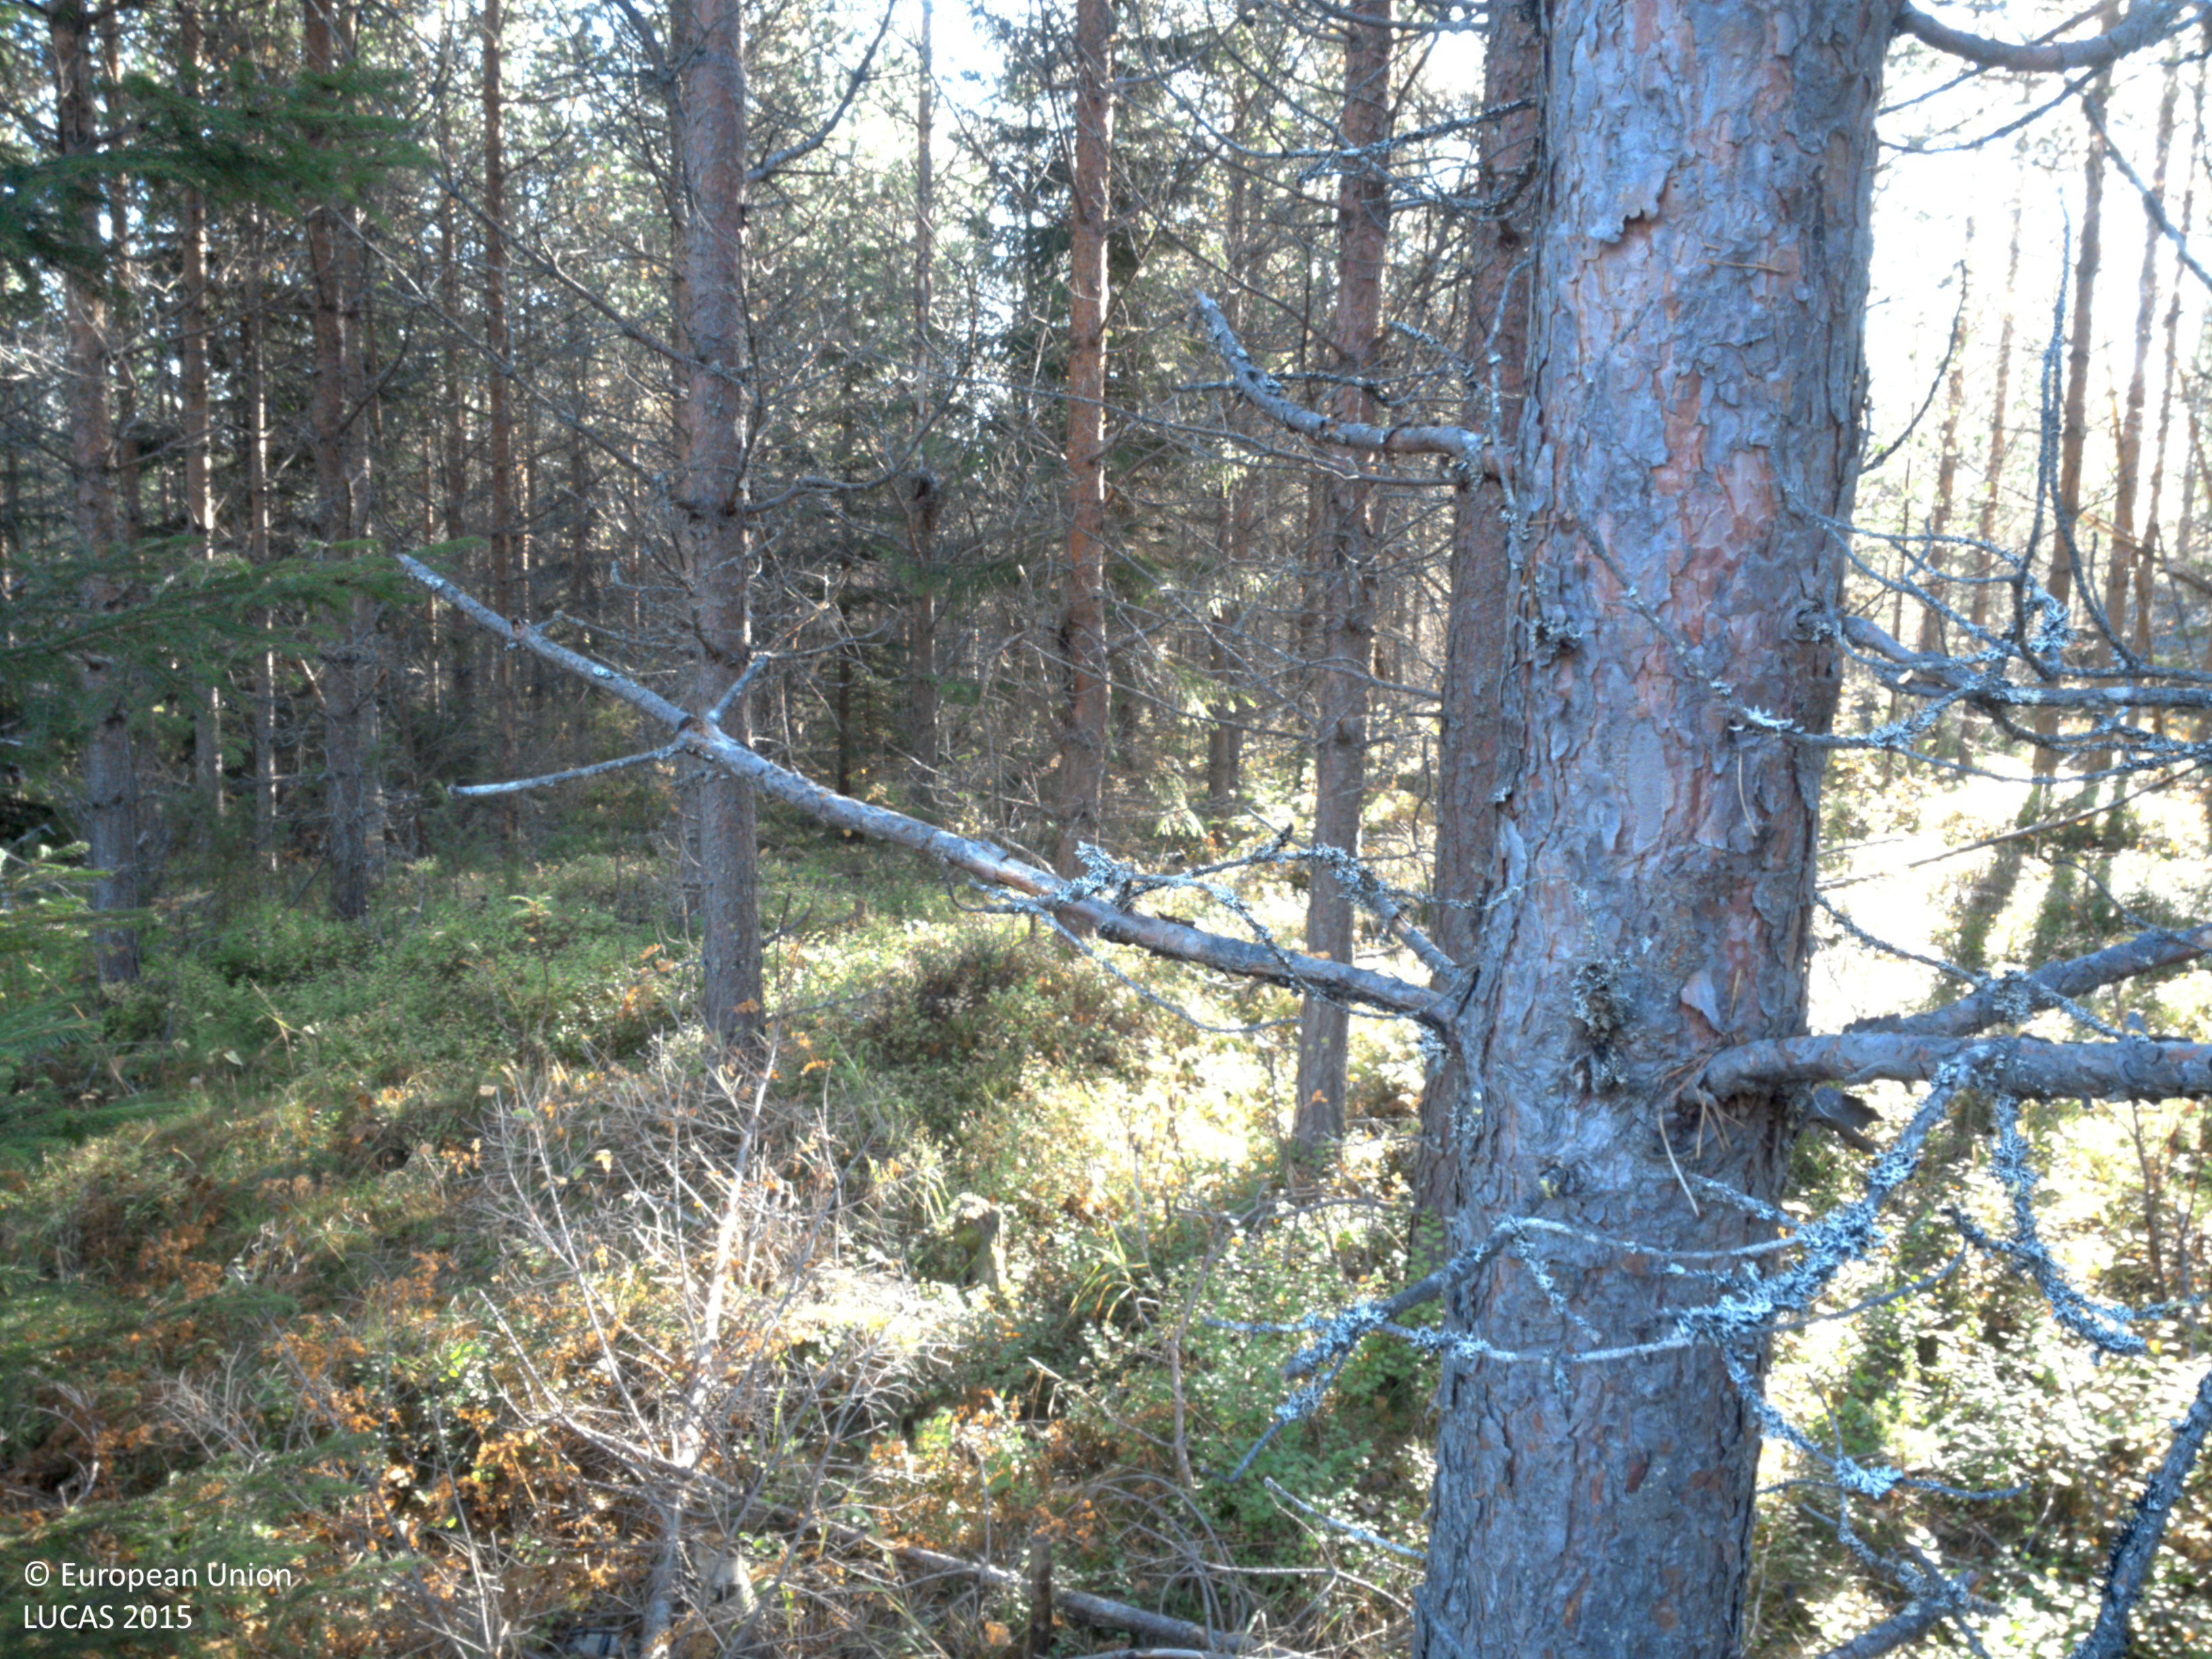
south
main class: Woodland
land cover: Pine dominated coniferous woodland
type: boreal forest
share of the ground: > 75 %
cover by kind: coniferous forest trees 85 %, shrubs 10 %, lichens and mosses 5 %
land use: Forestry
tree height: > 5 m
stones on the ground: < 10 %
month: October
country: SE
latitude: 63.8792
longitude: 18.8299
